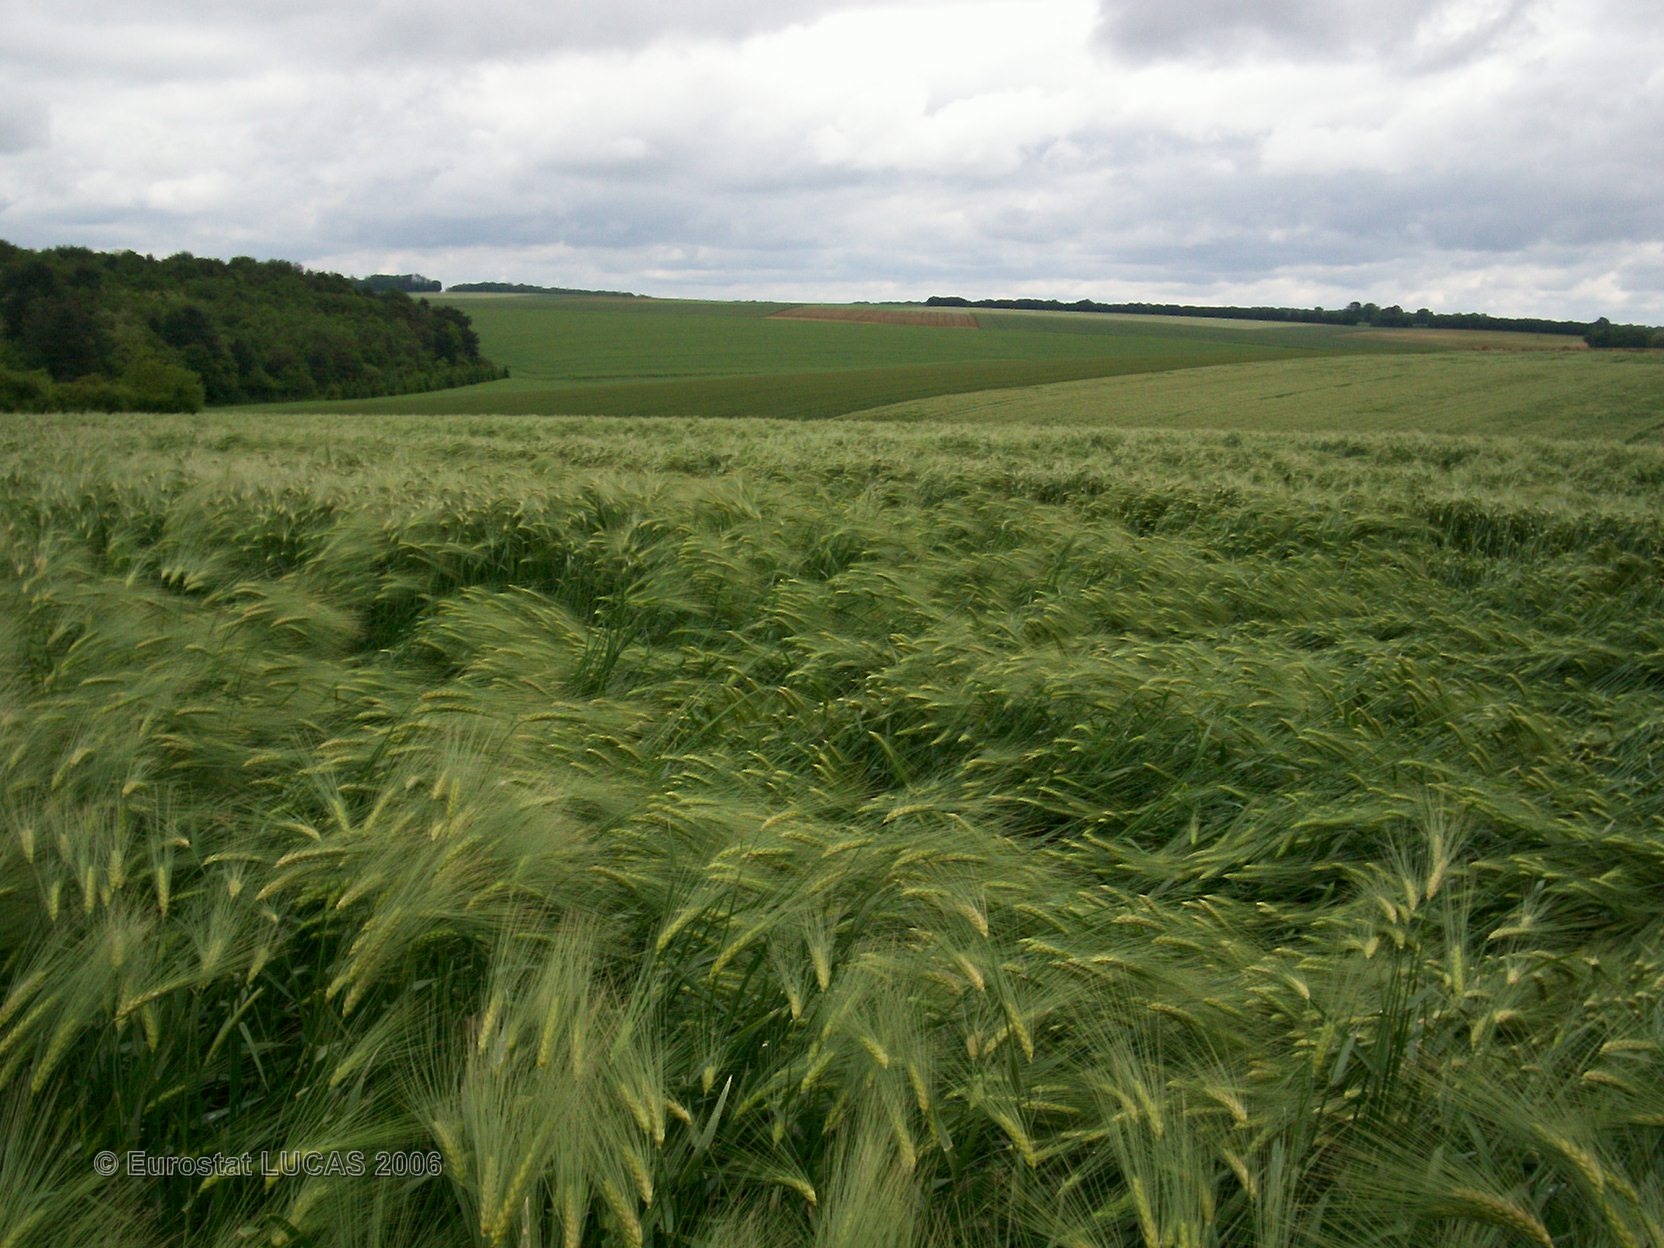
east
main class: Cropland
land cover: Barley
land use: Agriculture (excluding fallow land and kitchen gardens)
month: May
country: FR
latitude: 48.2149
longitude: 4.5471
